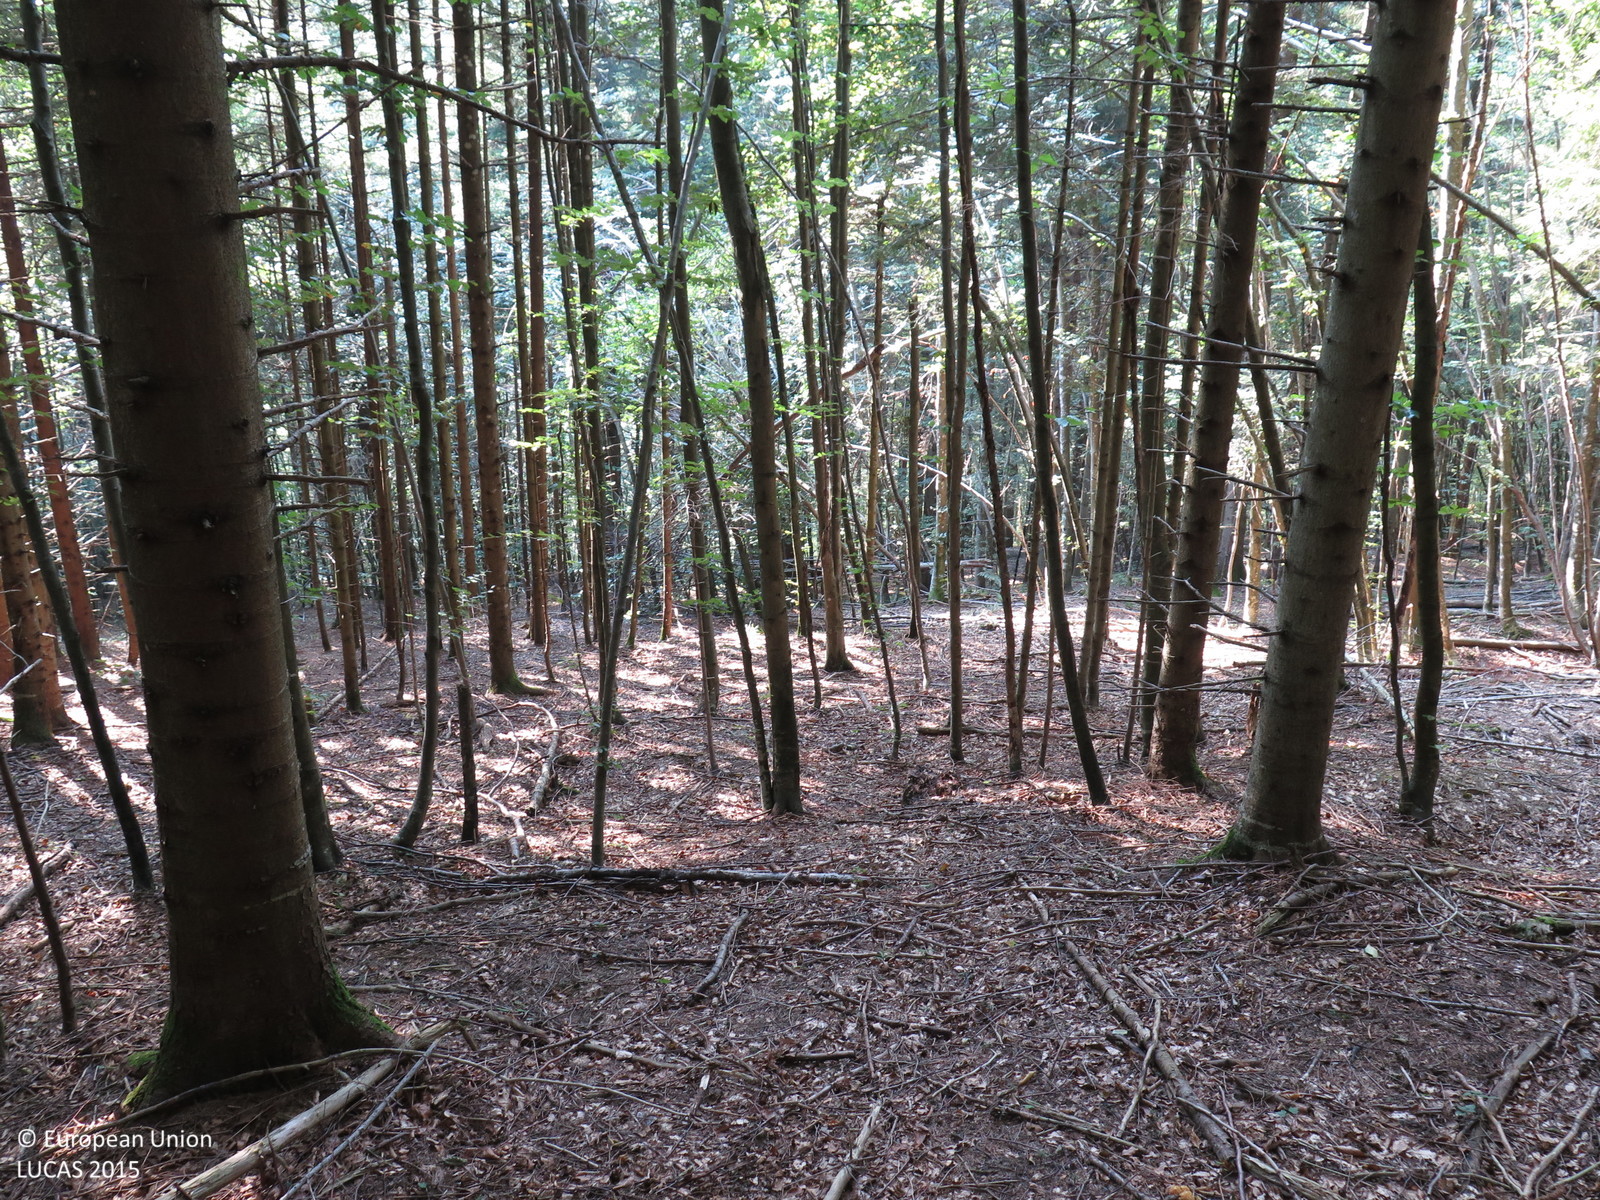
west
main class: Woodland
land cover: Other mixed woodland
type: beech forest
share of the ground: > 75 %
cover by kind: coniferous forest trees 75 %, broadleaved forest trees 25 %
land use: Forestry
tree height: > 5 m
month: August
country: HR
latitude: 45.3469
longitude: 15.0623
